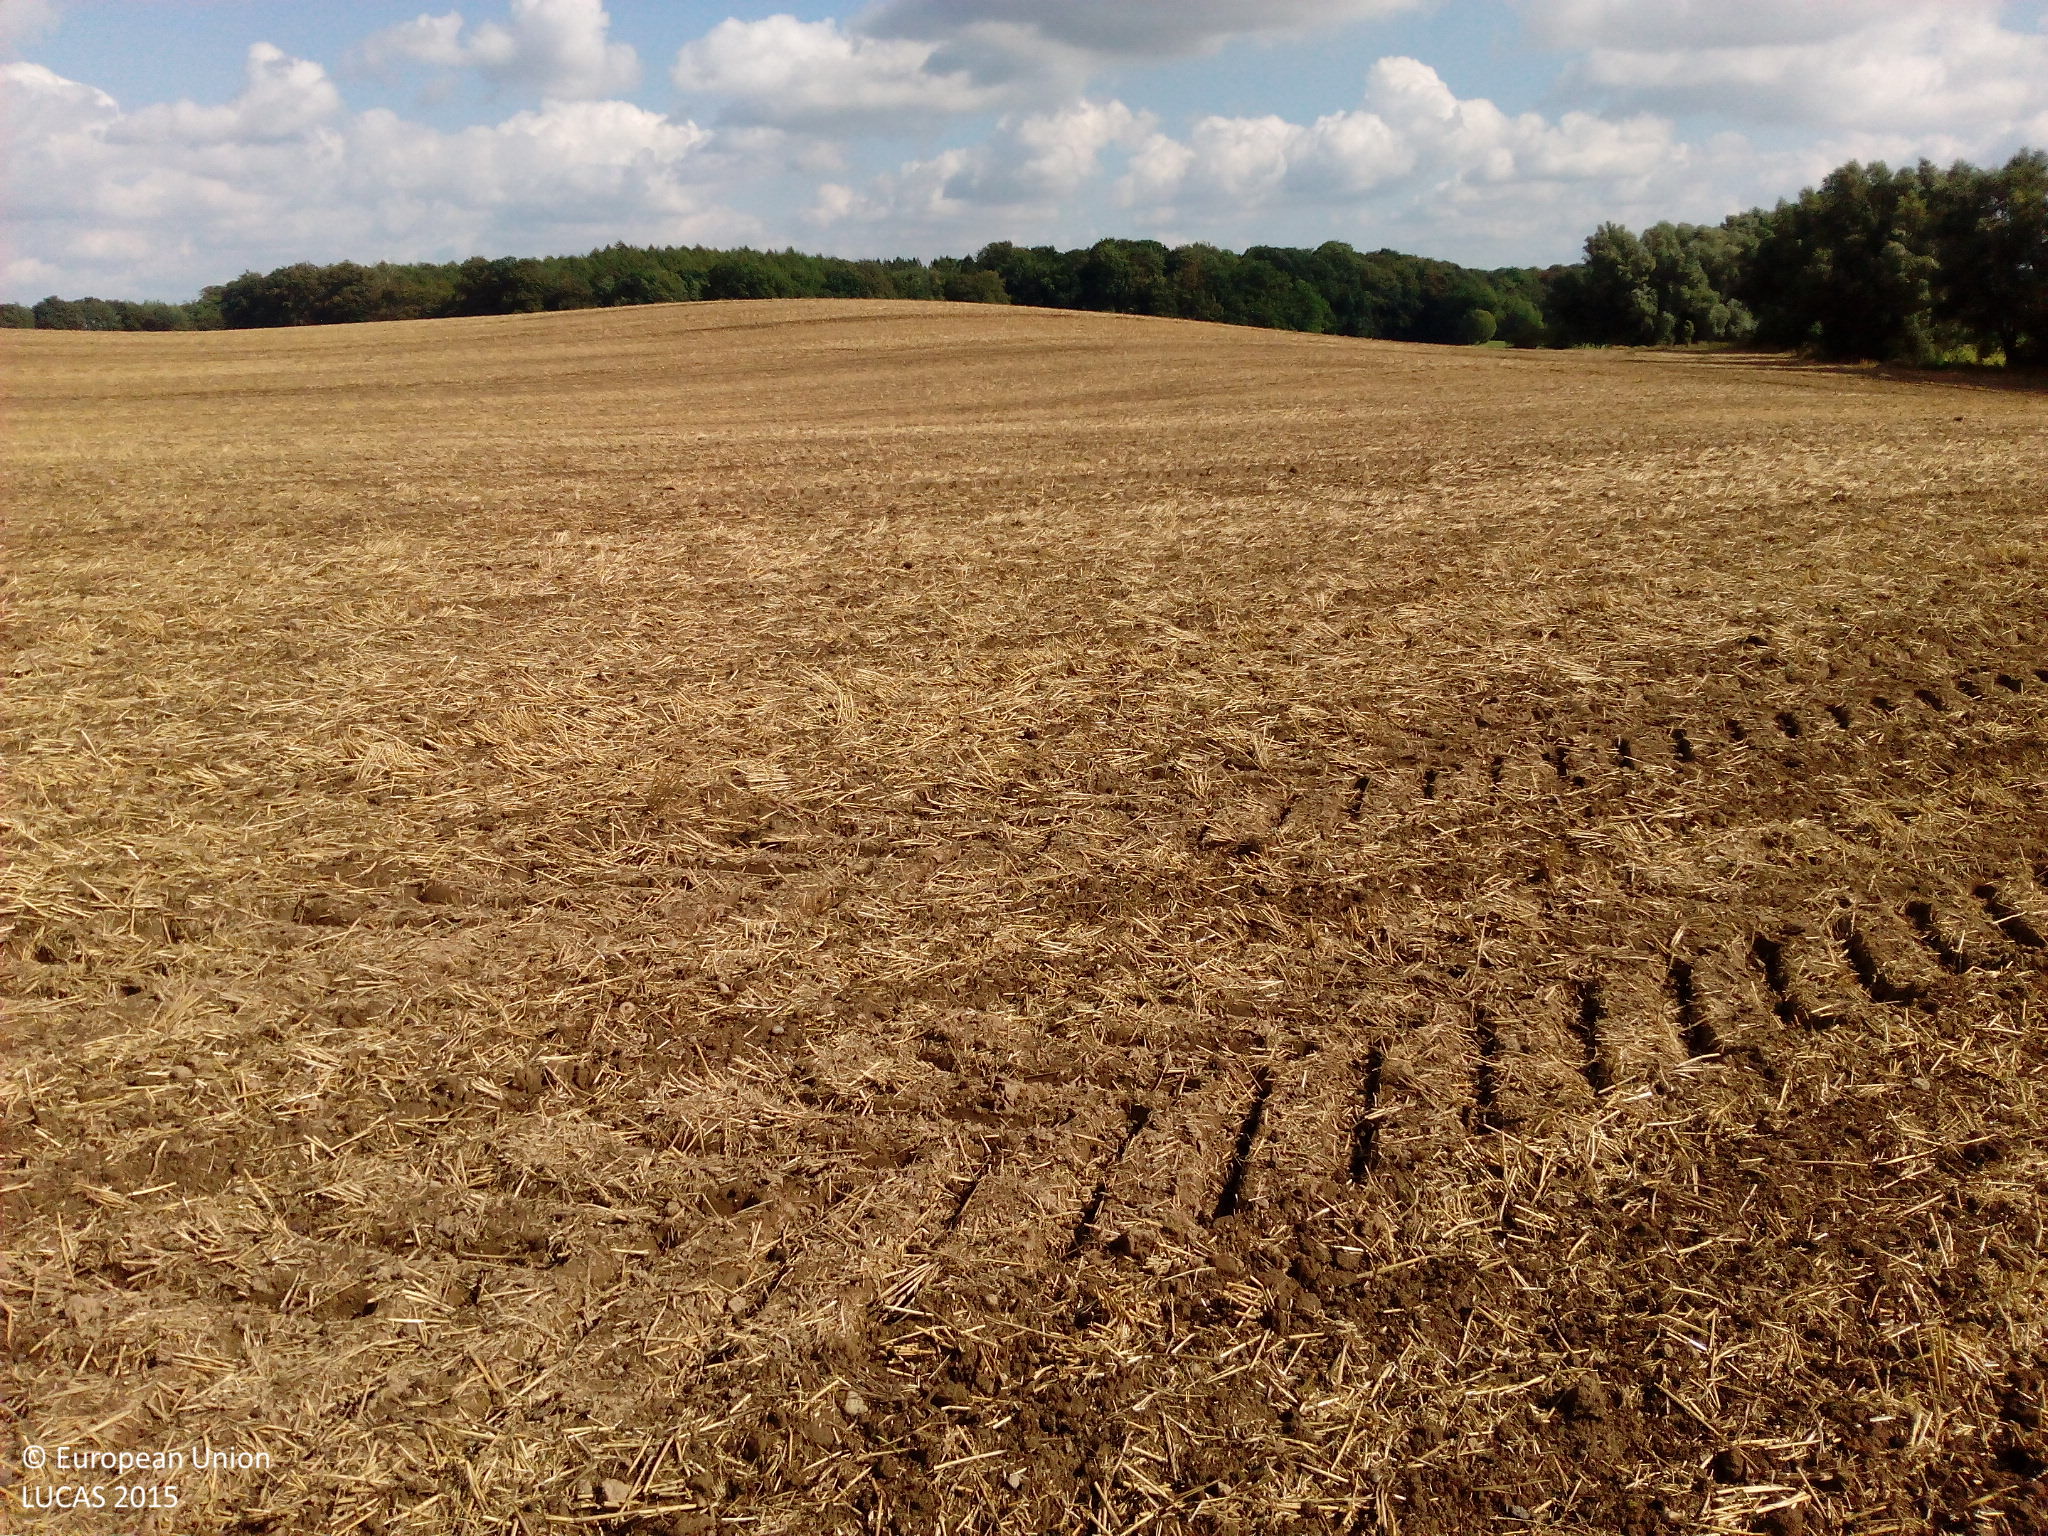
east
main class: Cropland
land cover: Common wheat
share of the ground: 25 - 50 %
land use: Agriculture (excluding fallow land and kitchen gardens)
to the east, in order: Common wheat
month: August
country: DE
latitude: 54.0392
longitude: 12.6103
